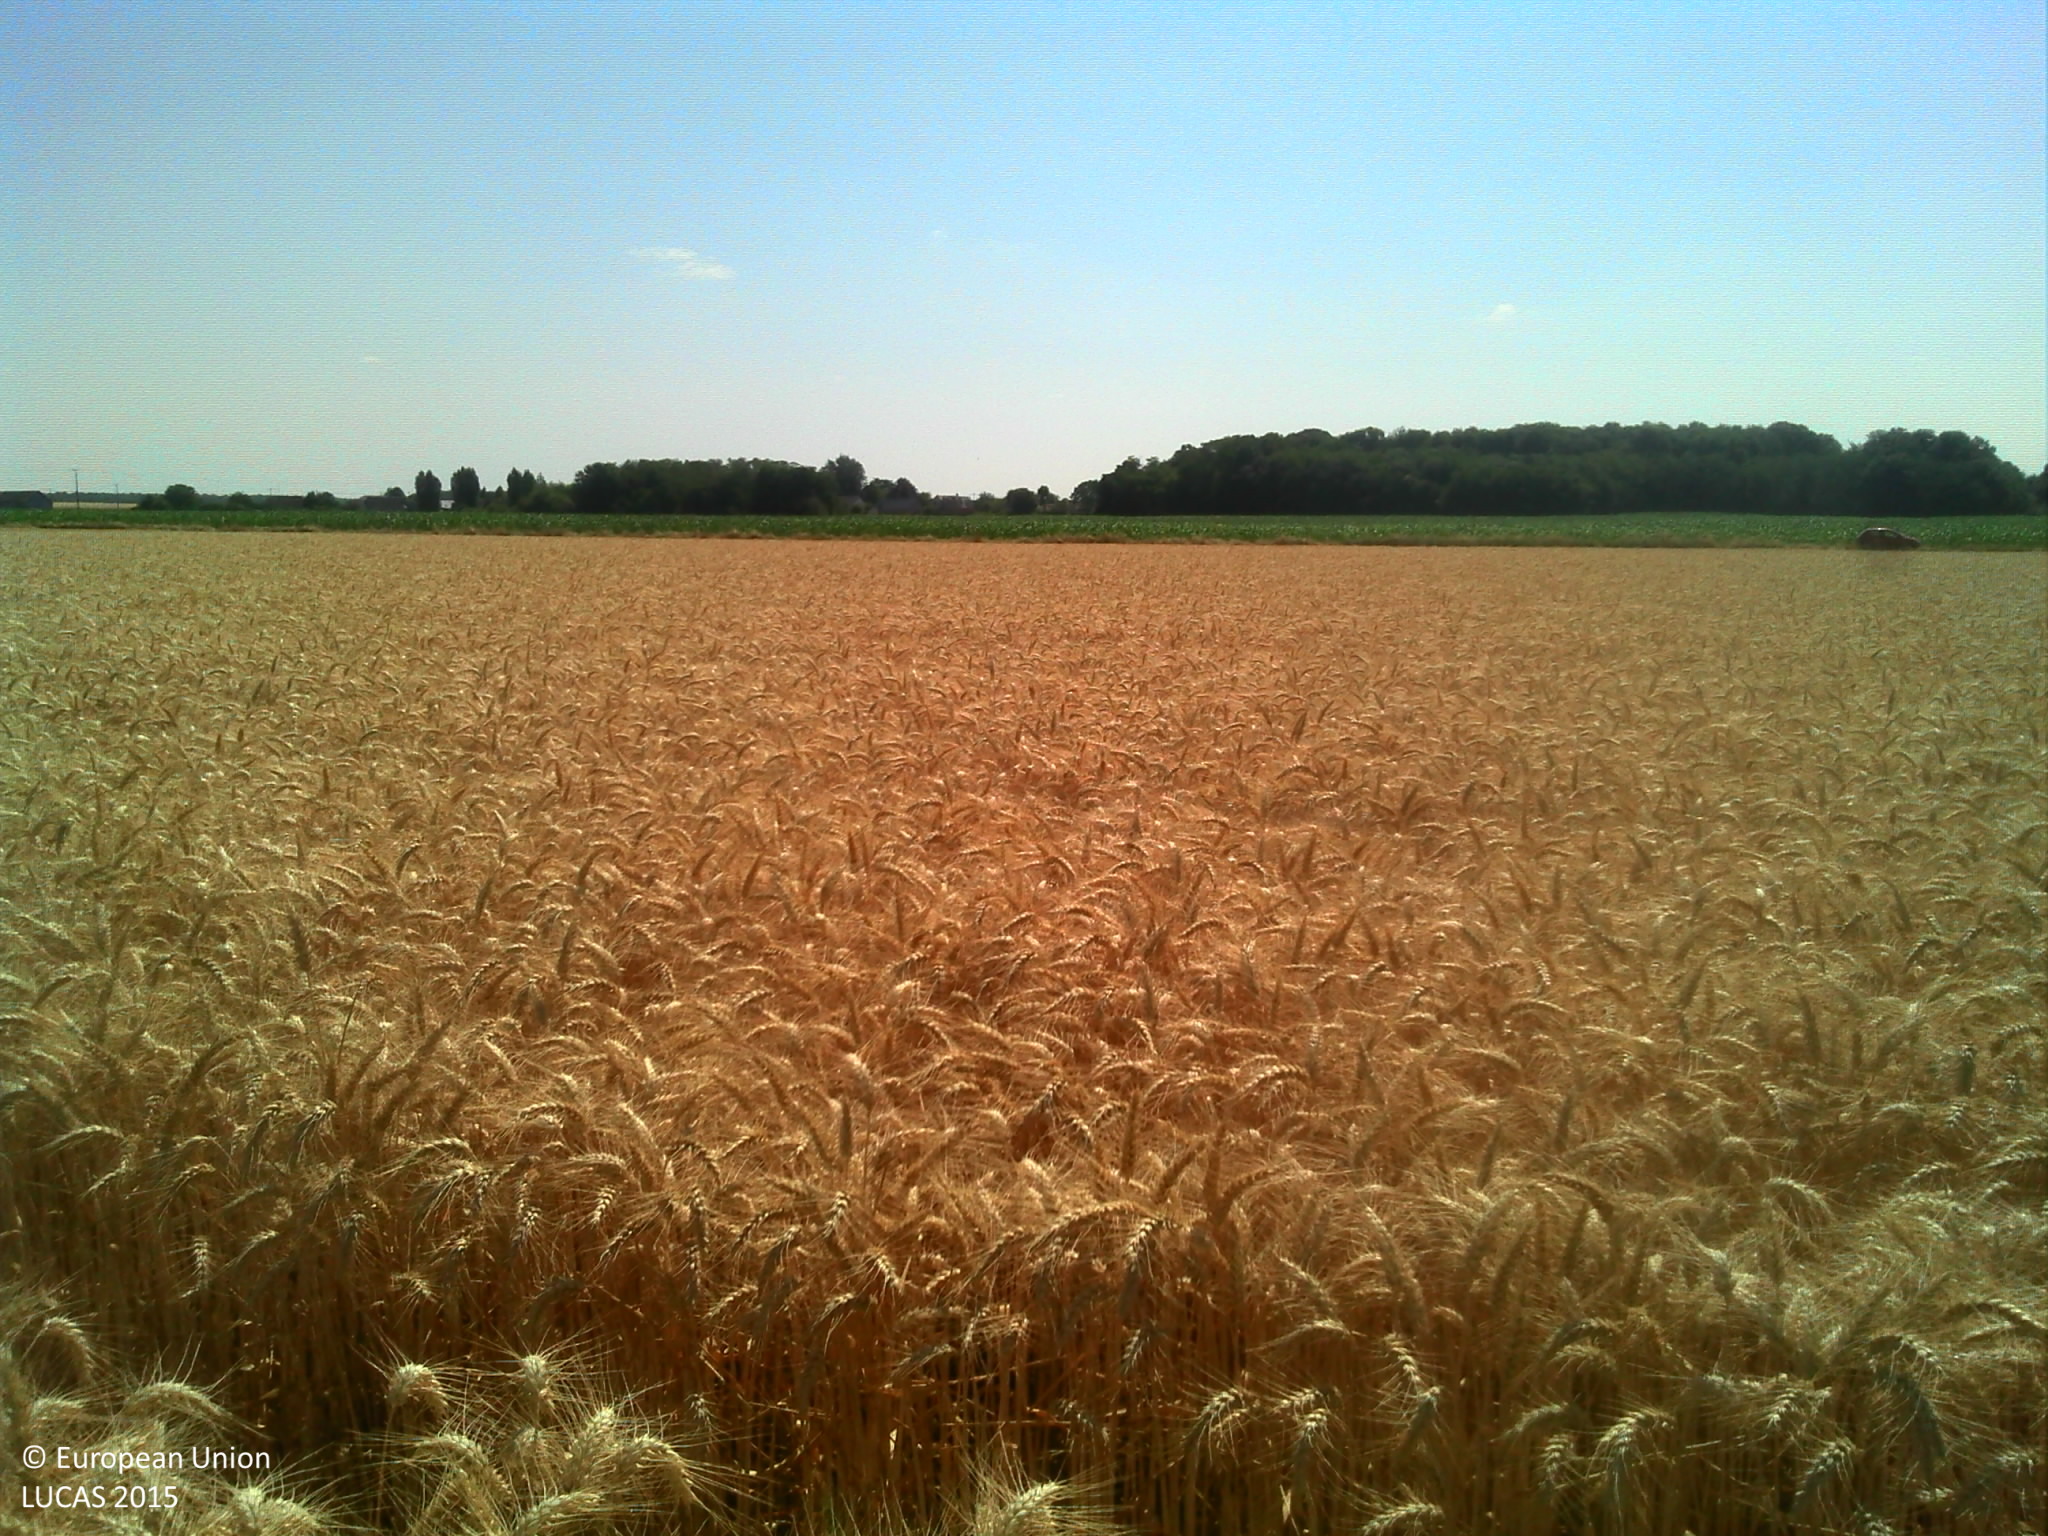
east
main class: Cropland
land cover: Common wheat
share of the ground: > 75 %
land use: Agriculture (excluding fallow land and kitchen gardens)
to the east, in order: Common wheat; Barley; Tracks; Maize
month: July
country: FR
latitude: 48.1137
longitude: 1.2921
